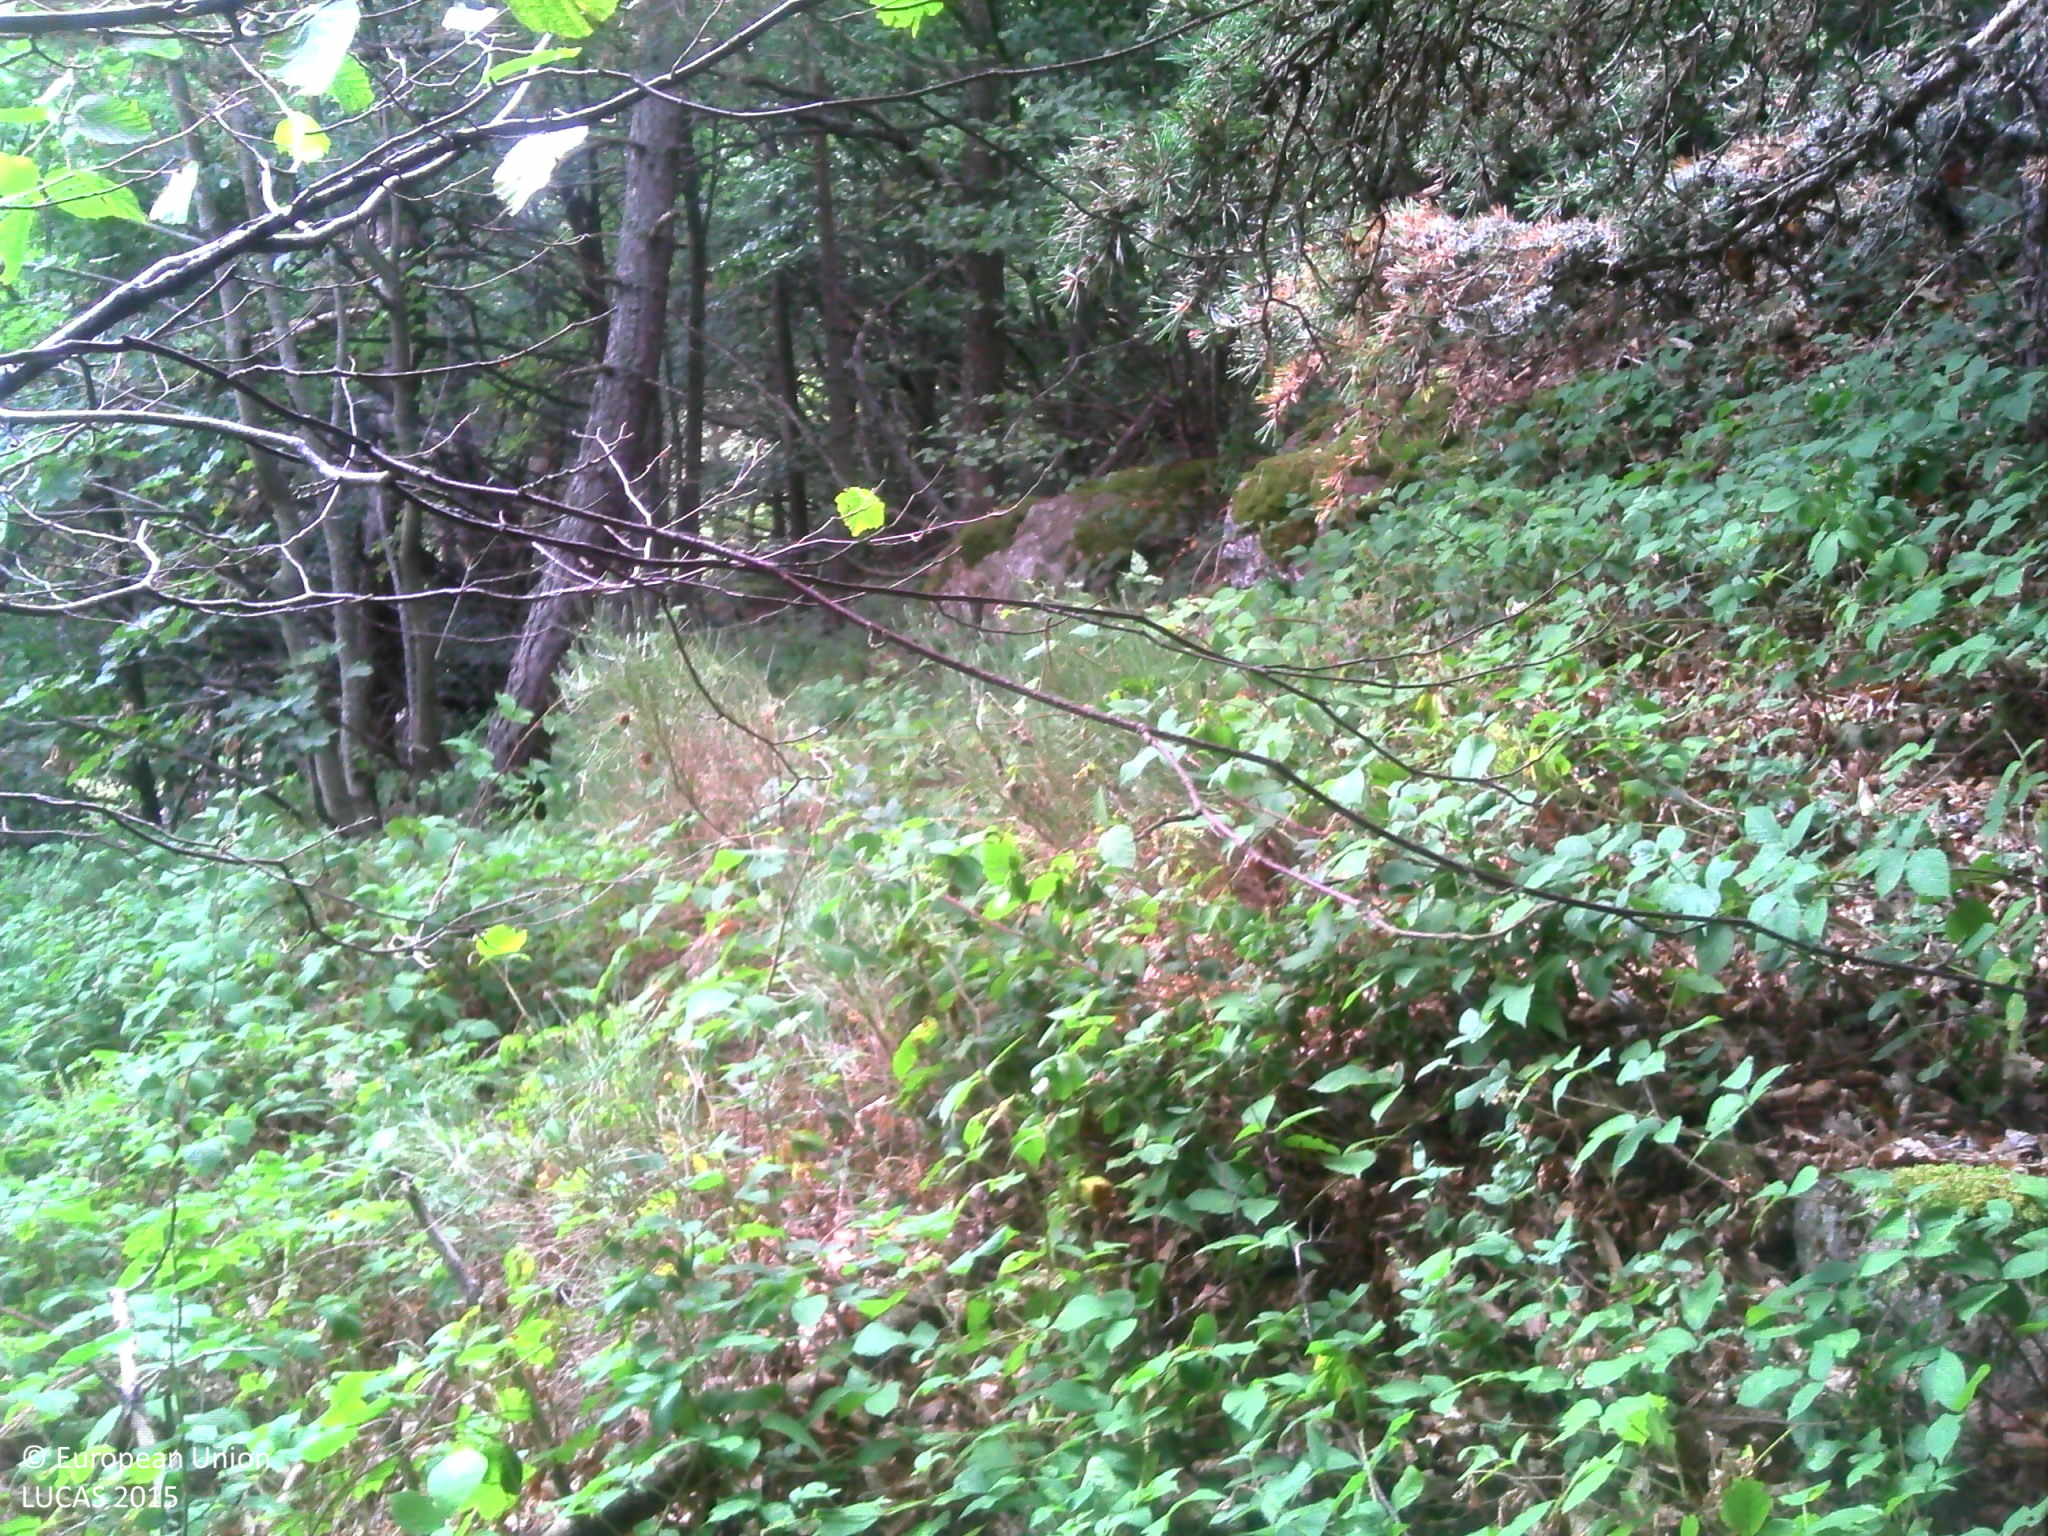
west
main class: Woodland
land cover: Pine dominated mixed woodland
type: mountainous beech forest
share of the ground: > 75 %
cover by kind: coniferous forest trees 45 %, broadleaved forest trees 30 %, herbaceous plants 25 %
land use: Semi-natural and natural areas not in use
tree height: > 5 m
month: August
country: FR
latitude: 45.2354
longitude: 4.5144
